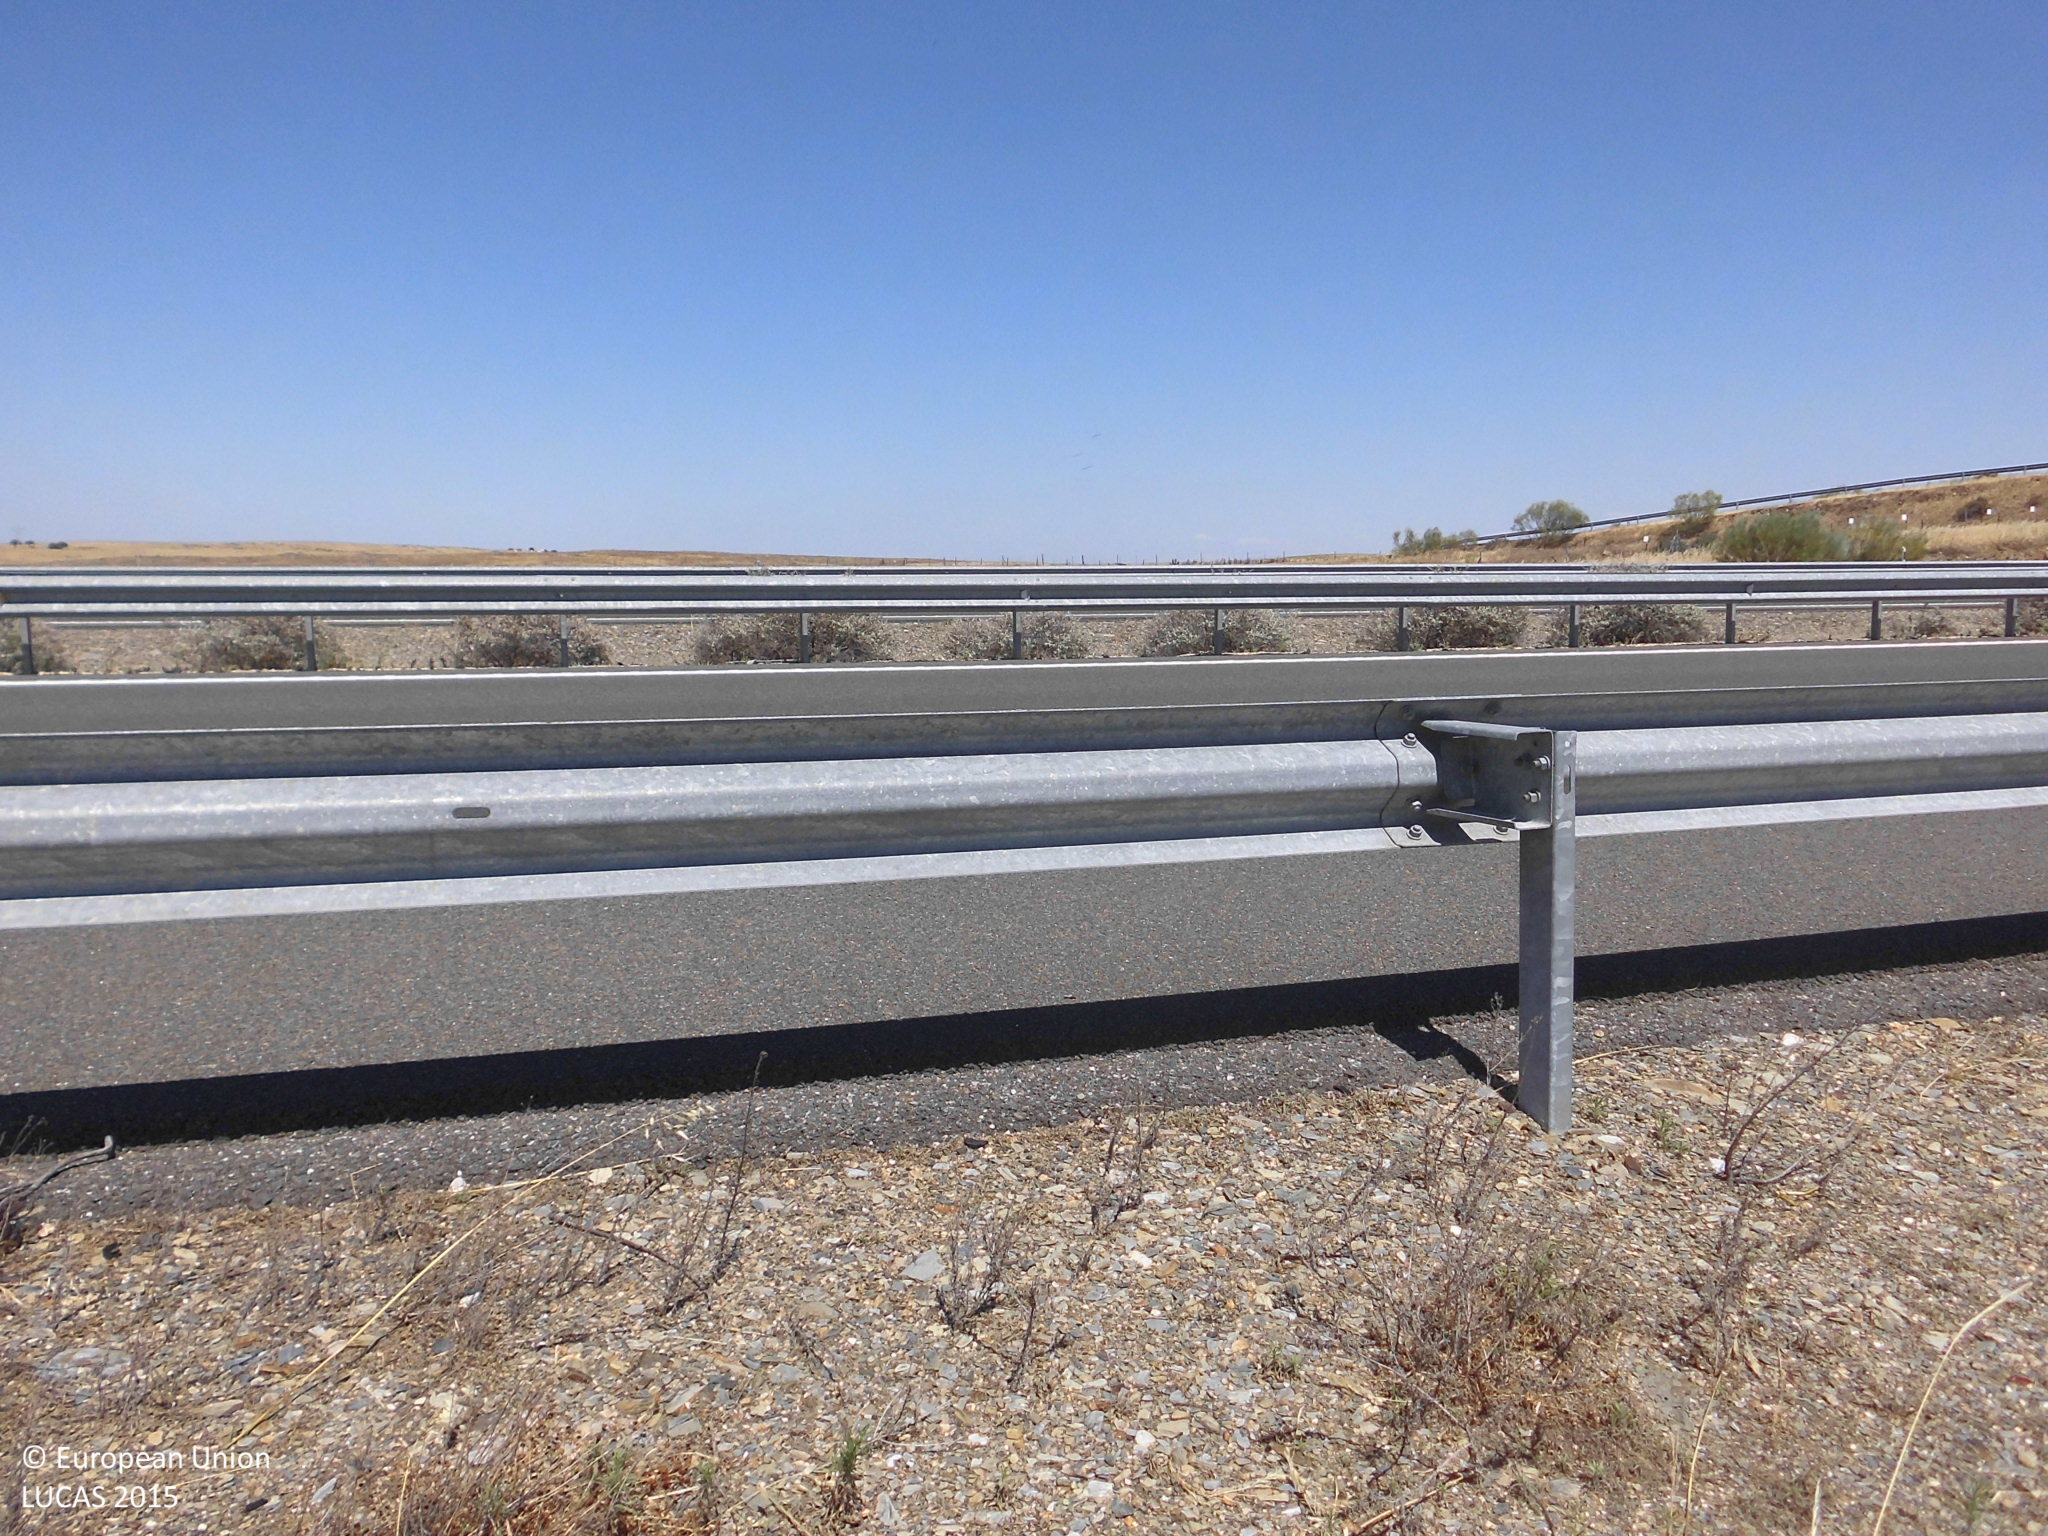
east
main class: Grassland
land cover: Spontaneously vegetated surfaces
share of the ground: 25 - 50 %
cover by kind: consolidated bare surface 75 %, herbaceous plants 25 %
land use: Road transport
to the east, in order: Spontaneously vegetated surfaces; Paved roads, cycling and walking lanes; Shruby margins; Spontaneously vegetated surfaces; Paved roads, cycling and walking lanes; Grassland without tree/shrub cover; Fences; Grassland without tree/shrub cover; Fences; Grass margins; Tracks; Grass margins; Tracks; Fences; Grassland without tree/shrub cover; Fences; Grassland without tree/shrub cover
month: June
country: ES
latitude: 39.5760
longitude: -6.4035
